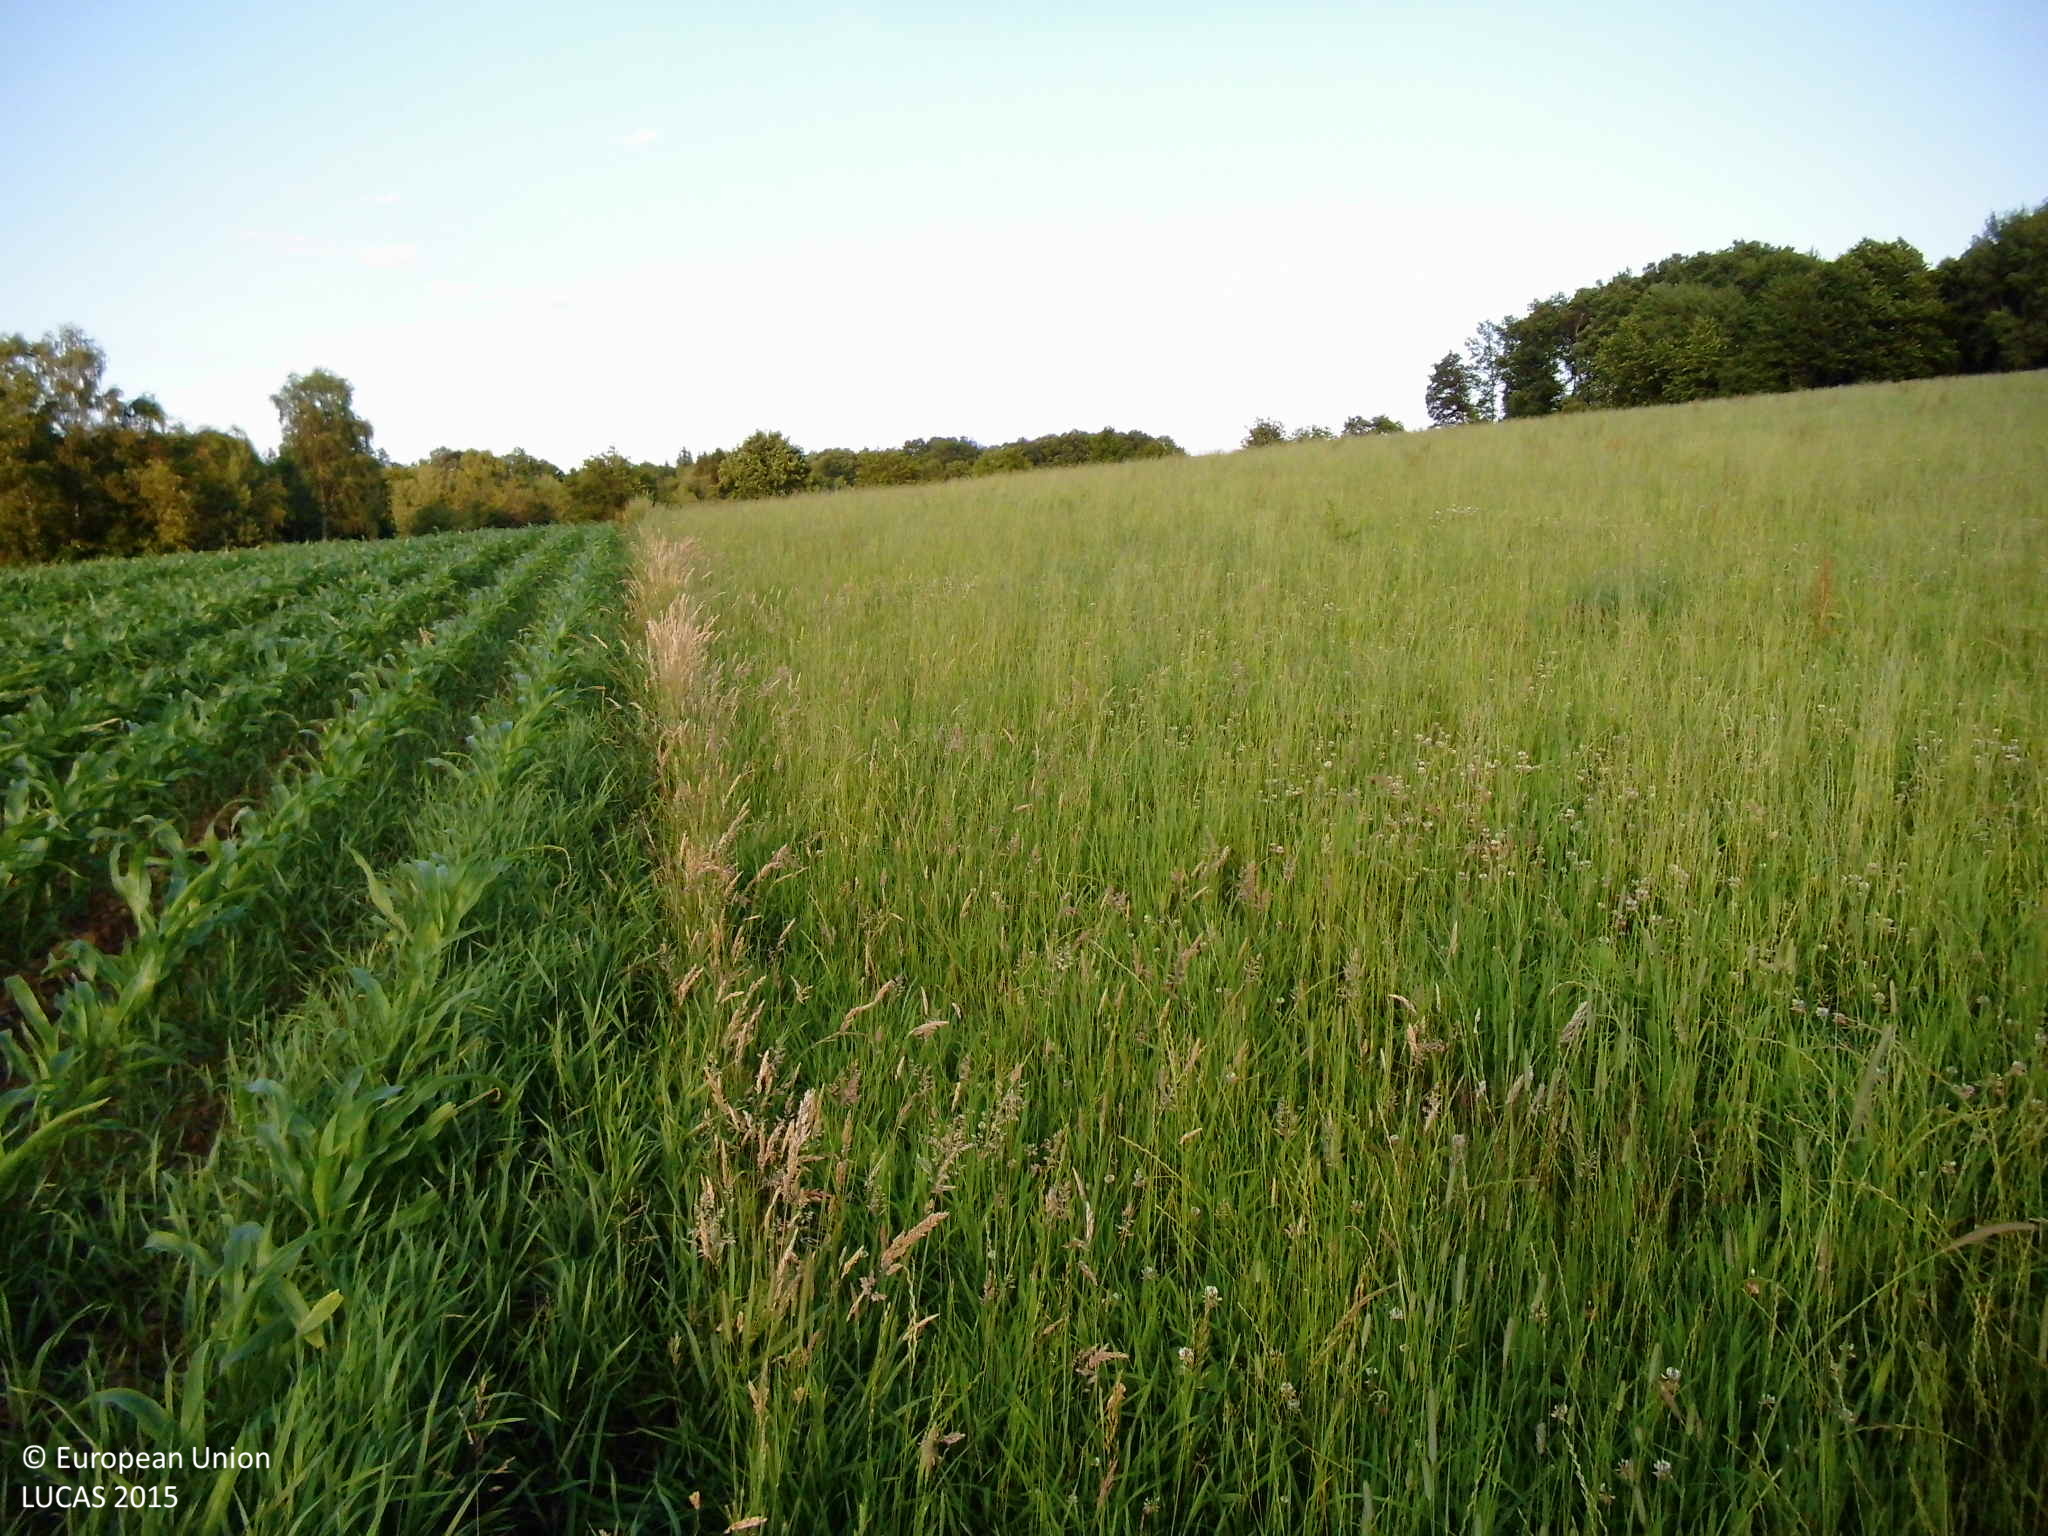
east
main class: Cropland
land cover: Maize
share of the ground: 50 - 75 %
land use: Agriculture (excluding fallow land and kitchen gardens)
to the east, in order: Maize; Grassland without tree/shrub cover; Paved roads, cycling and walking lanes; Grass margins; Ditches and canals; Electric lines; Abandoned hedges; Fences; Grassland without tree/shrub cover; Single bushes/trees; Grassland without tree/shrub cover
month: June
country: DE
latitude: 50.8575
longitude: 7.4573
